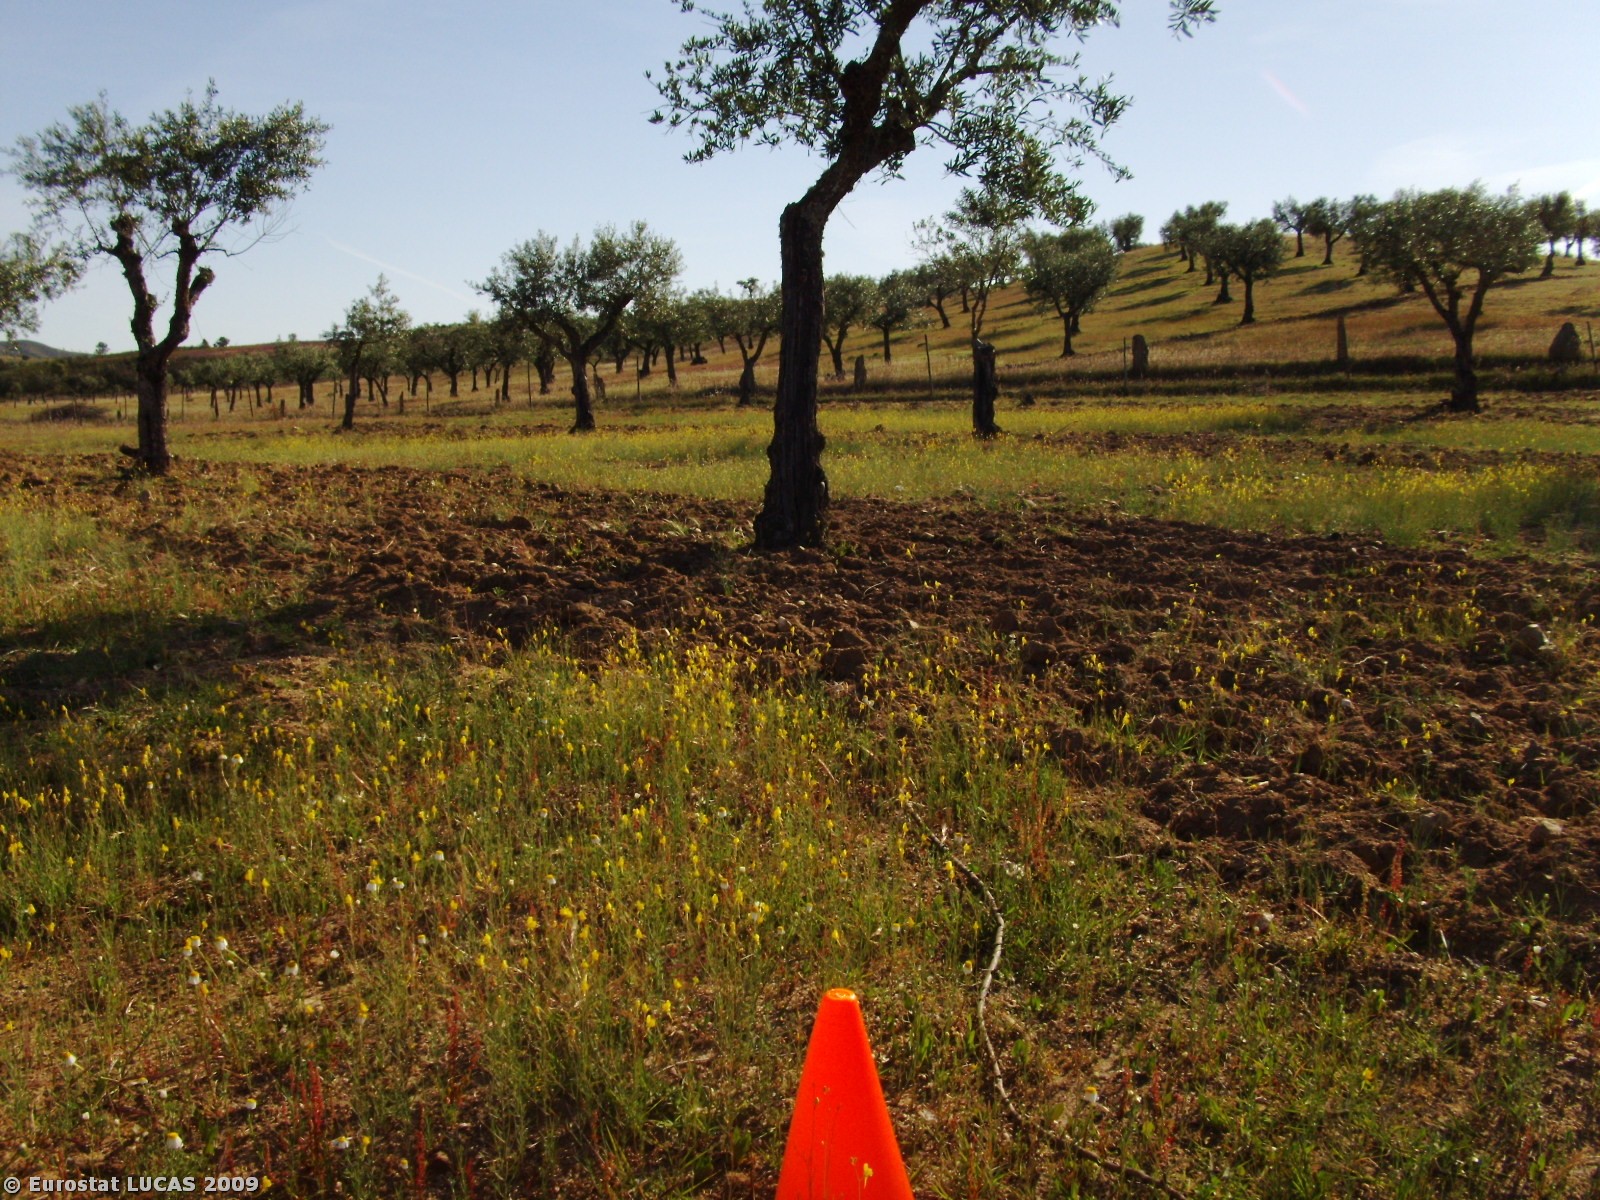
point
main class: Cropland
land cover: Olive groves
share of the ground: 10 - 25 %
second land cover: Spontaneously vegetated surfaces
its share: > 75 %
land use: Agriculture (excluding fallow land and kitchen gardens)
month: May
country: PT
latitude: 39.6996
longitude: -7.5808
